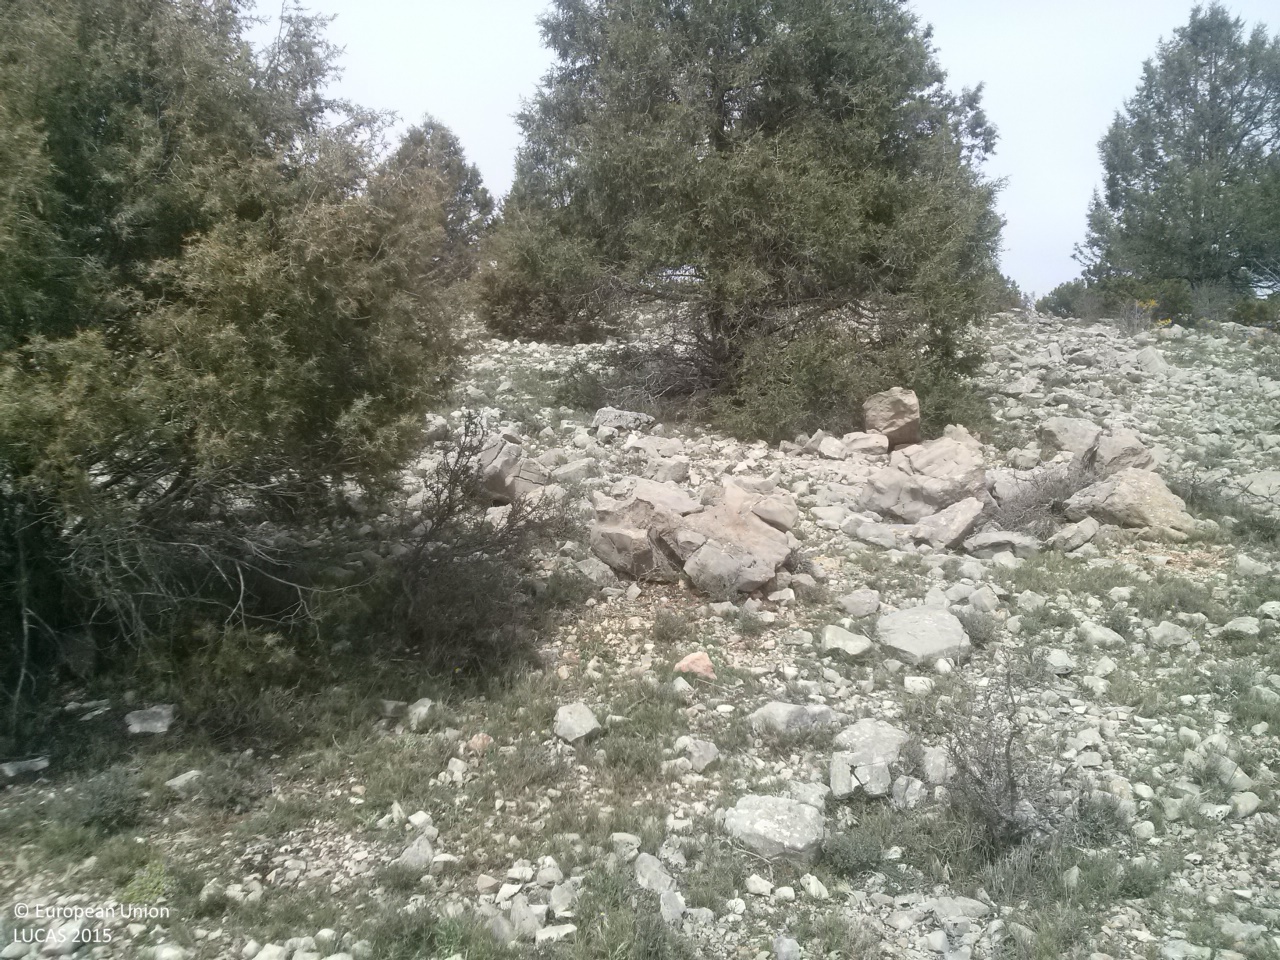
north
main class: Grassland
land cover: Grassland with sparse tree/shrub cover
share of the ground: 50 - 75 %
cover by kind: consolidated bare surface 55 %, herbaceous plants 35 %, coniferous forest trees 5 %, shrubs 5 %
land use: Semi-natural and natural areas not in use
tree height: < 5 m
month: April
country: ES
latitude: 40.0561
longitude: -1.8651
